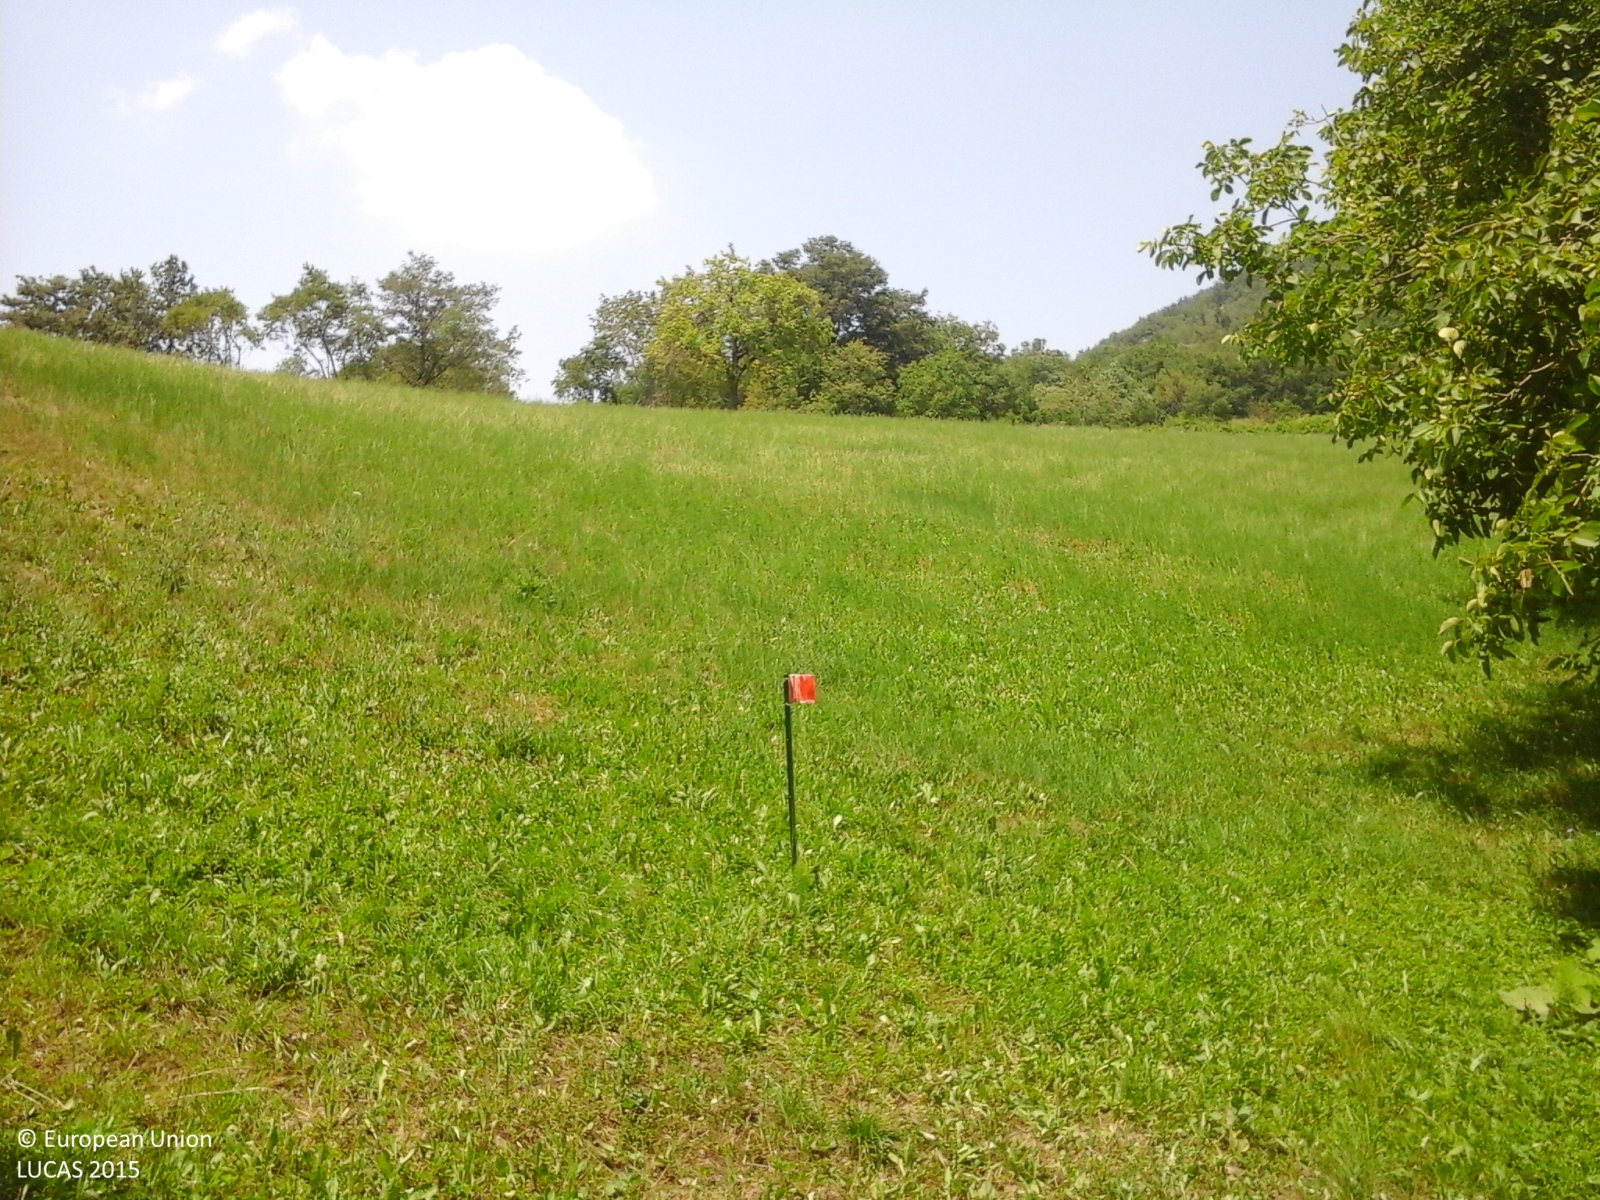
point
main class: Grassland
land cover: Grassland without tree/shrub cover
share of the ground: > 75 %
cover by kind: herbaceous plants 100 %
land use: Agriculture (excluding fallow land and kitchen gardens)
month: July
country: IT
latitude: 44.4764
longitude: 10.2885
